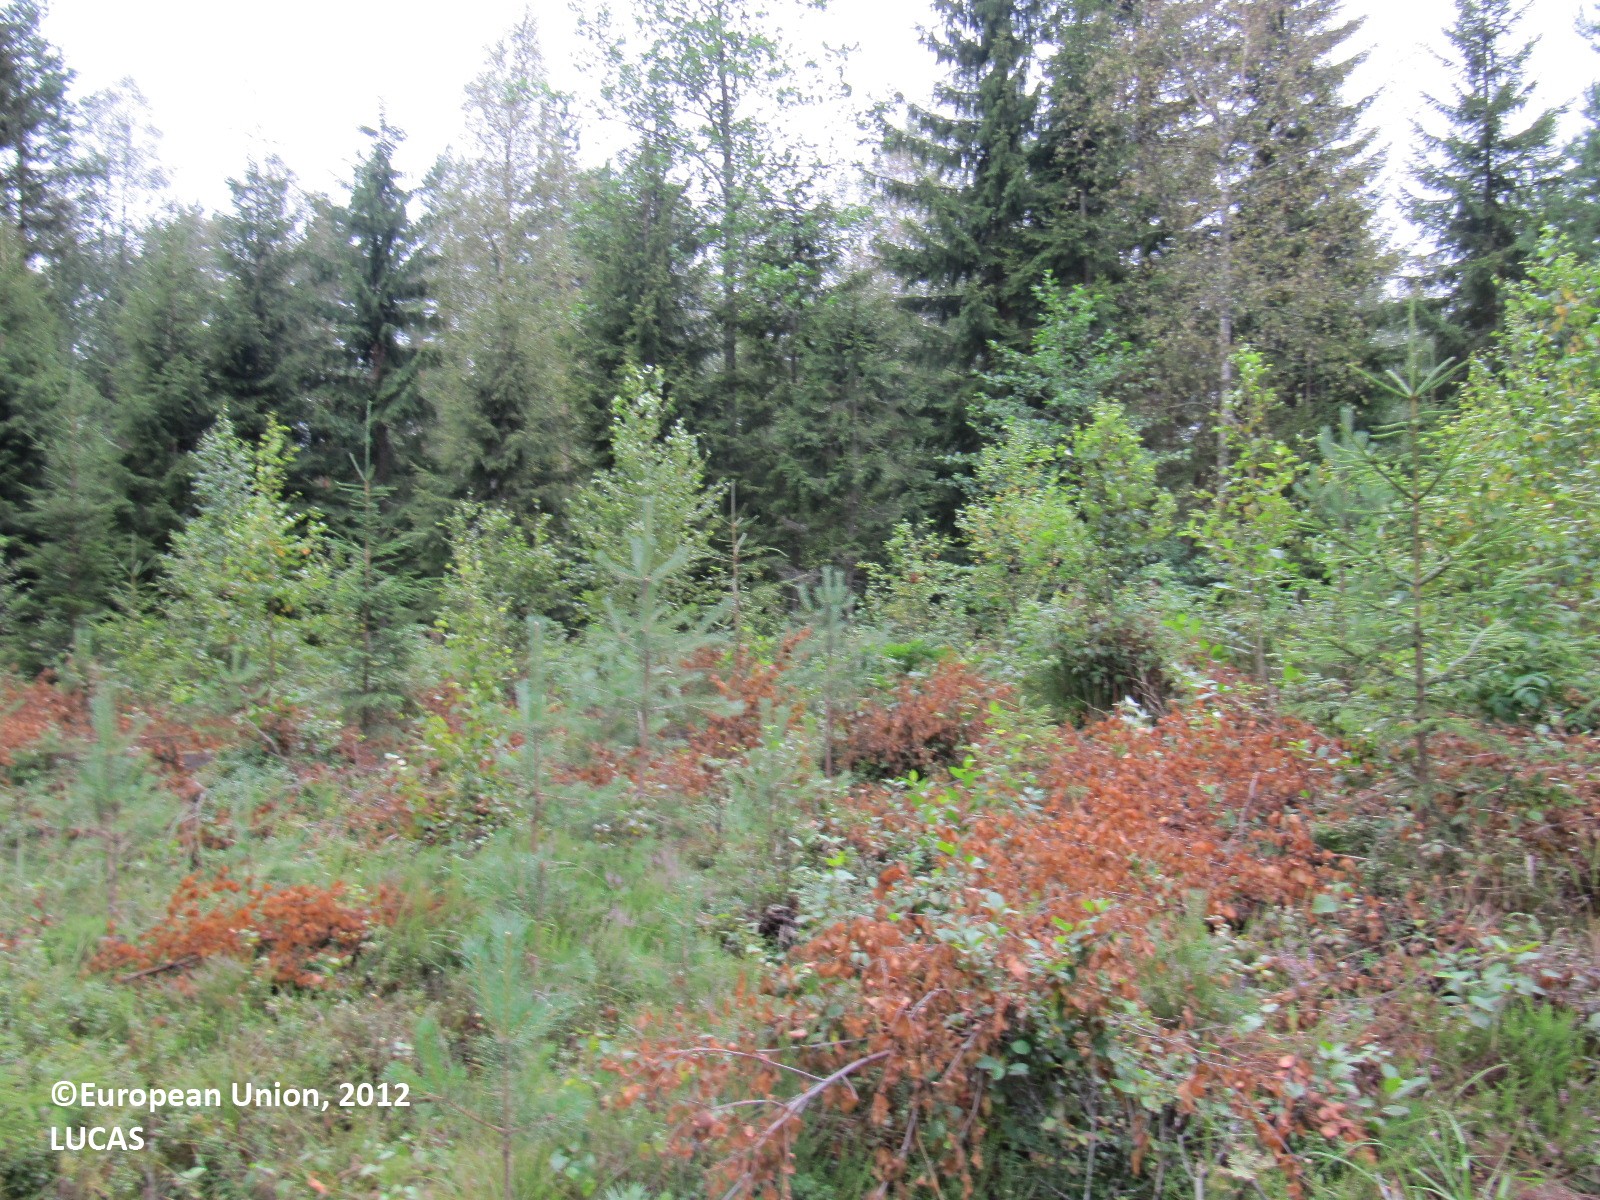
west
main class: Woodland
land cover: Pine dominated mixed woodland
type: boreal forest
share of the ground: > 75 %
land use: Forestry
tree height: > 5 m
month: August
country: FI
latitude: 60.2458
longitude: 23.0691
